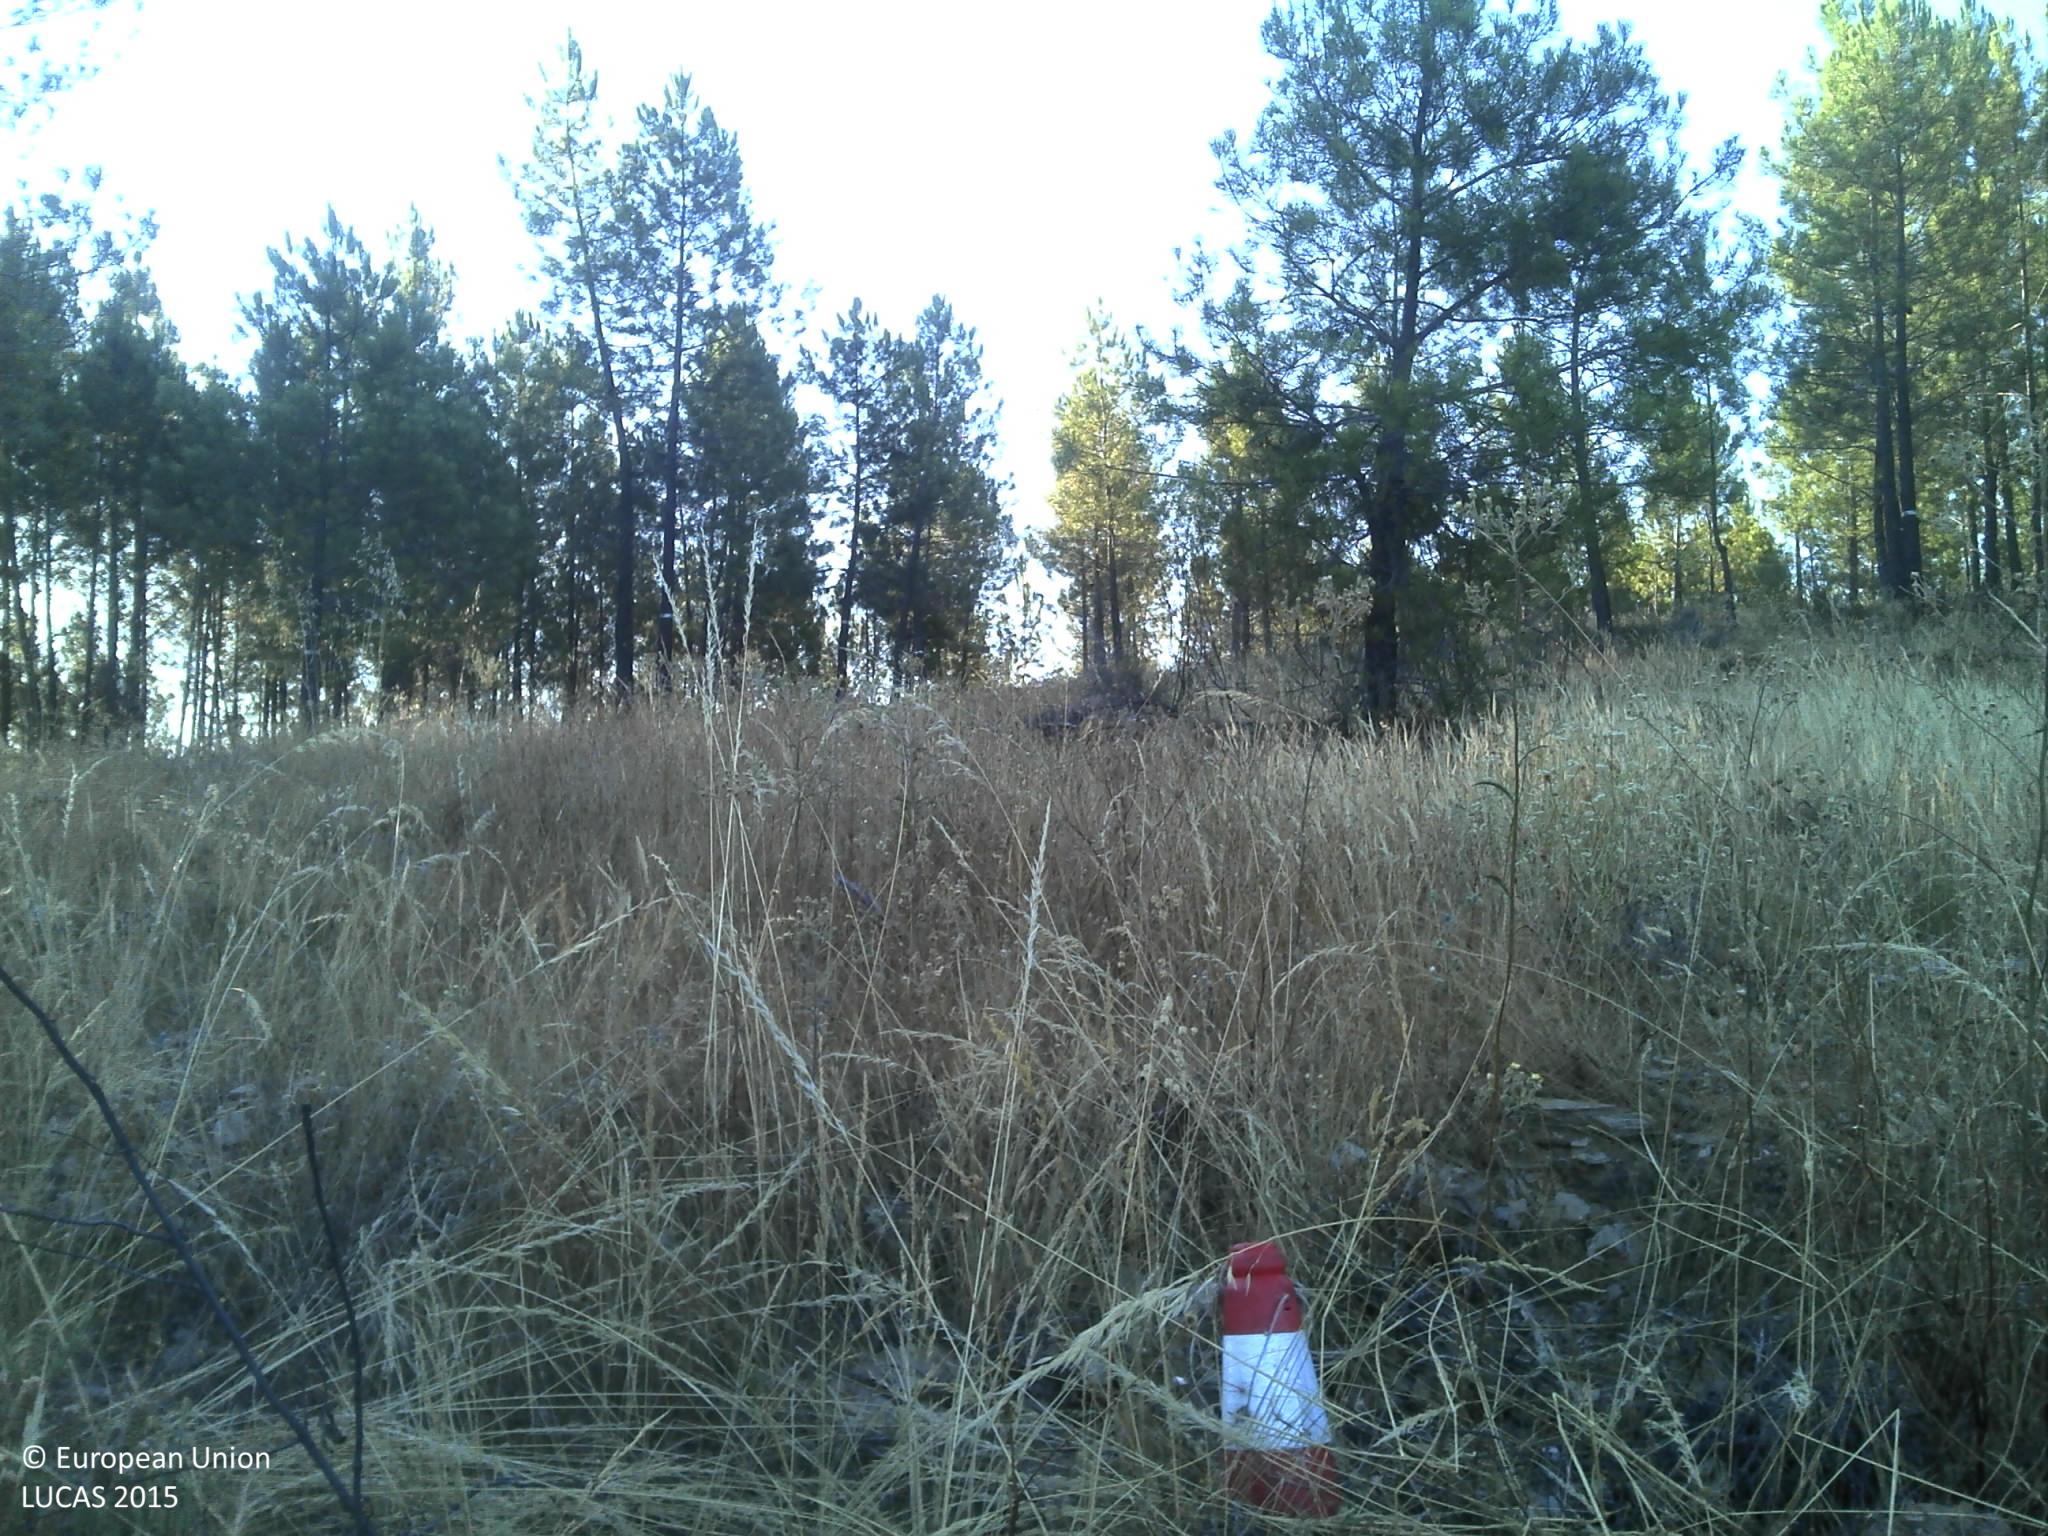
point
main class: Woodland
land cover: Pine dominated coniferous woodland
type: coniferous forest of the mediterranean region
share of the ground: 10 - 25 %
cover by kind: unconsolidated bare surface 30 %, coniferous forest trees 25 %, herbaceous plants 25 %, shrubs 20 %
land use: Forestry
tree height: > 5 m
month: July
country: PT
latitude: 39.9580
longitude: -7.5808
